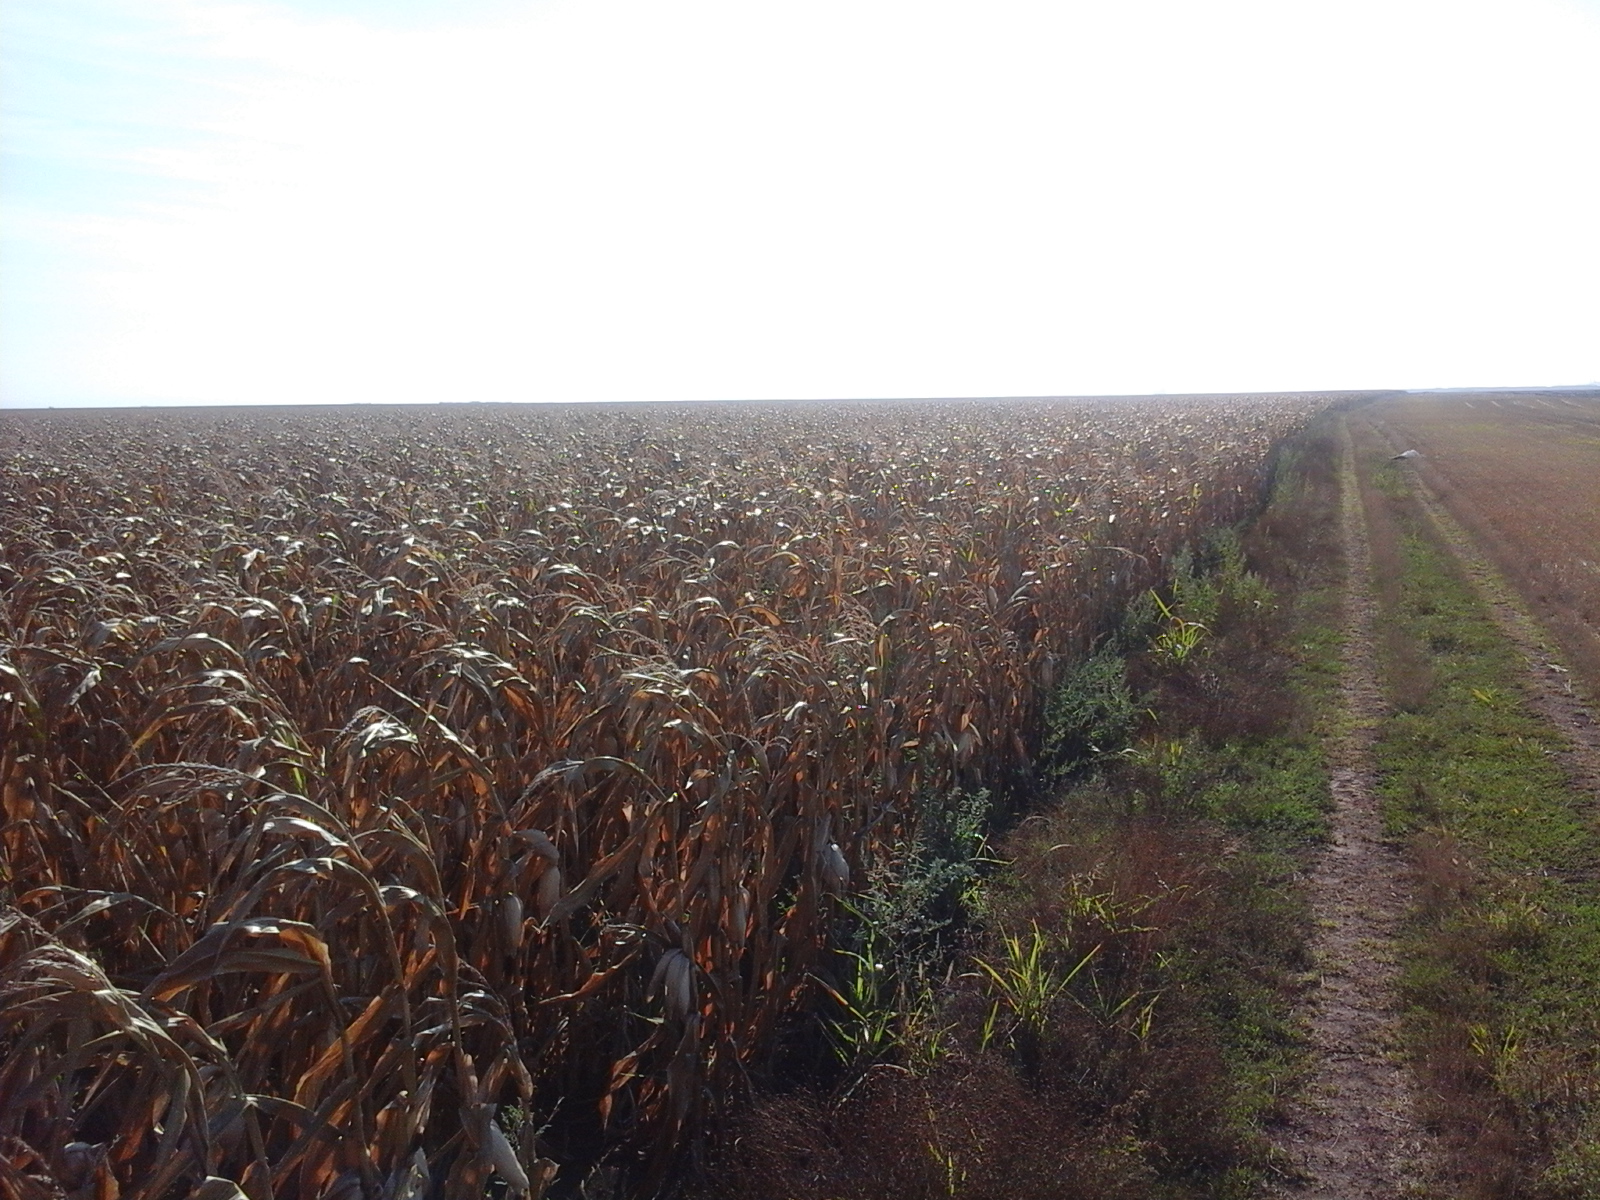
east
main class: Cropland
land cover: Maize
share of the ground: > 75 %
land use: Agriculture (excluding fallow land and kitchen gardens)
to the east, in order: Maize
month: August
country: RO
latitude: 46.0410
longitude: 21.1310
